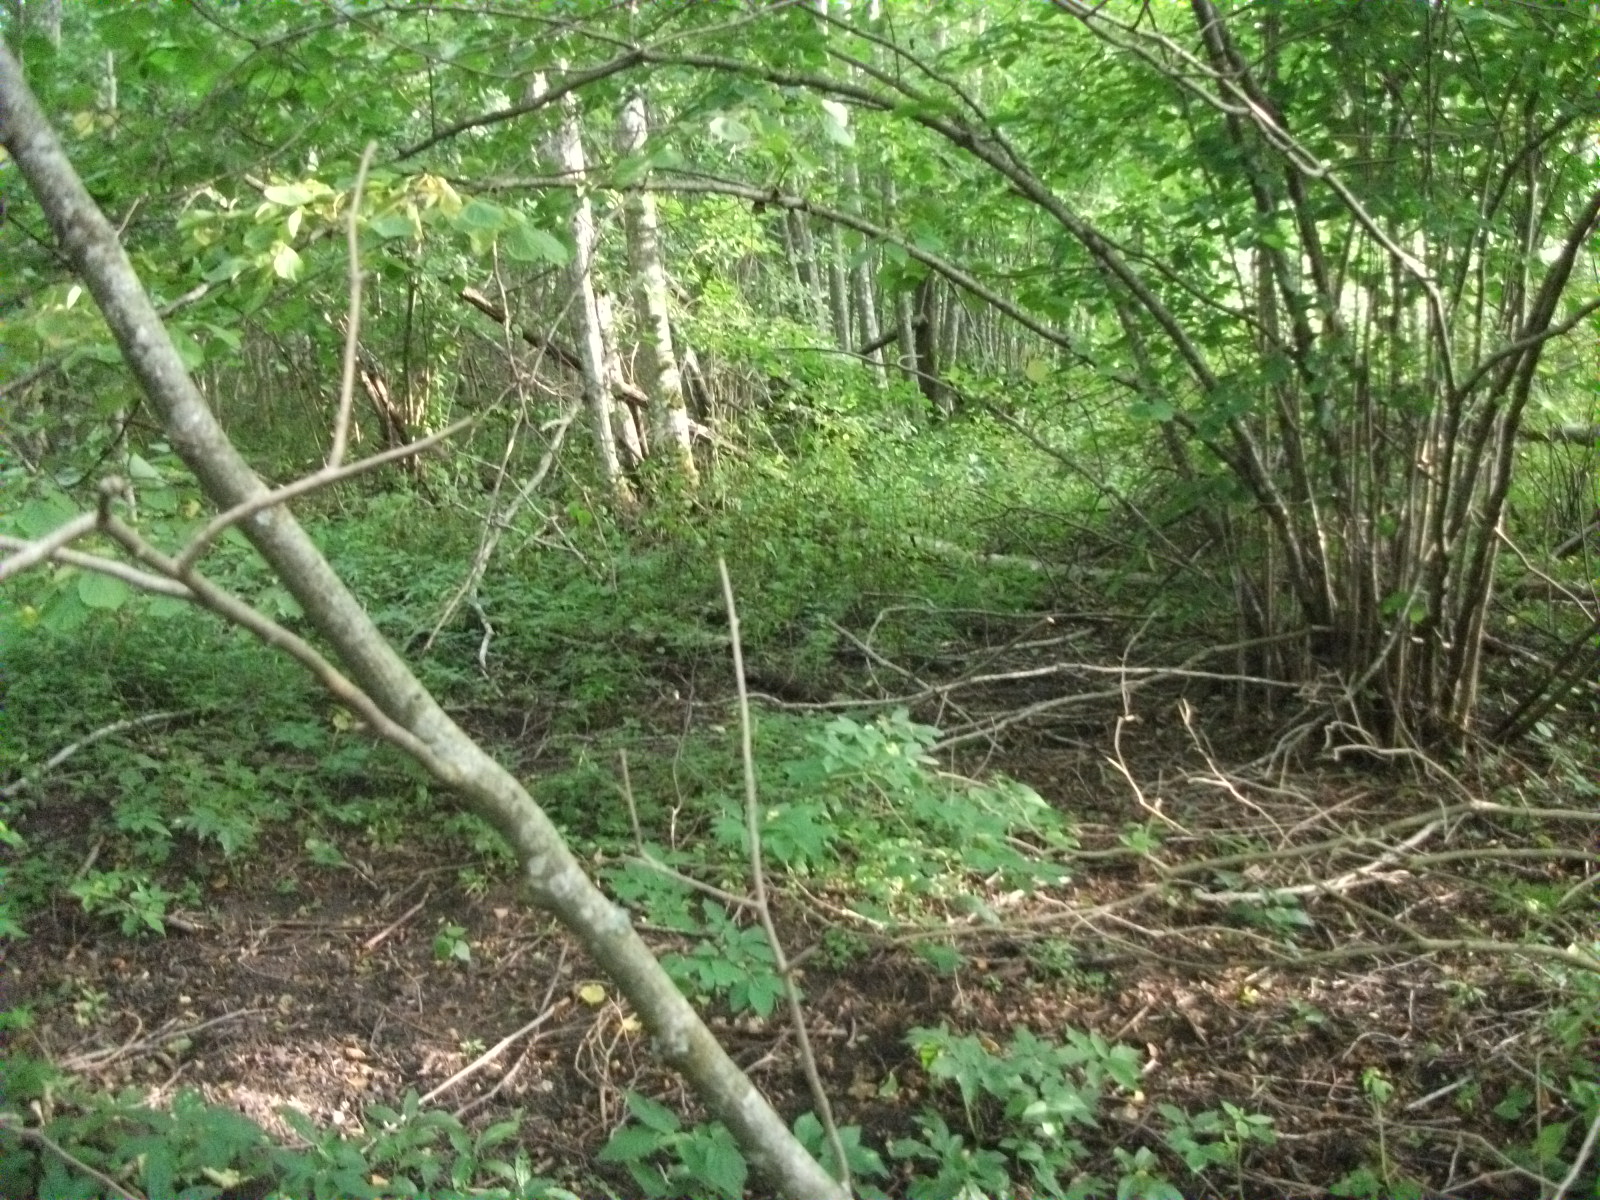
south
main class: Woodland
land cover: Broadleaved woodland
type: non-riverine alder, birch or aspen forest
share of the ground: > 75 %
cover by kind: broadleaved forest trees 75 %, herbaceous plants 10 %, coniferous forest trees 5 %, shrubs 5 %, unconsolidated bare surface 5 %
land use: Forestry
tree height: > 5 m
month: August
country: LV
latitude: 56.9004
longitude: 26.4483
